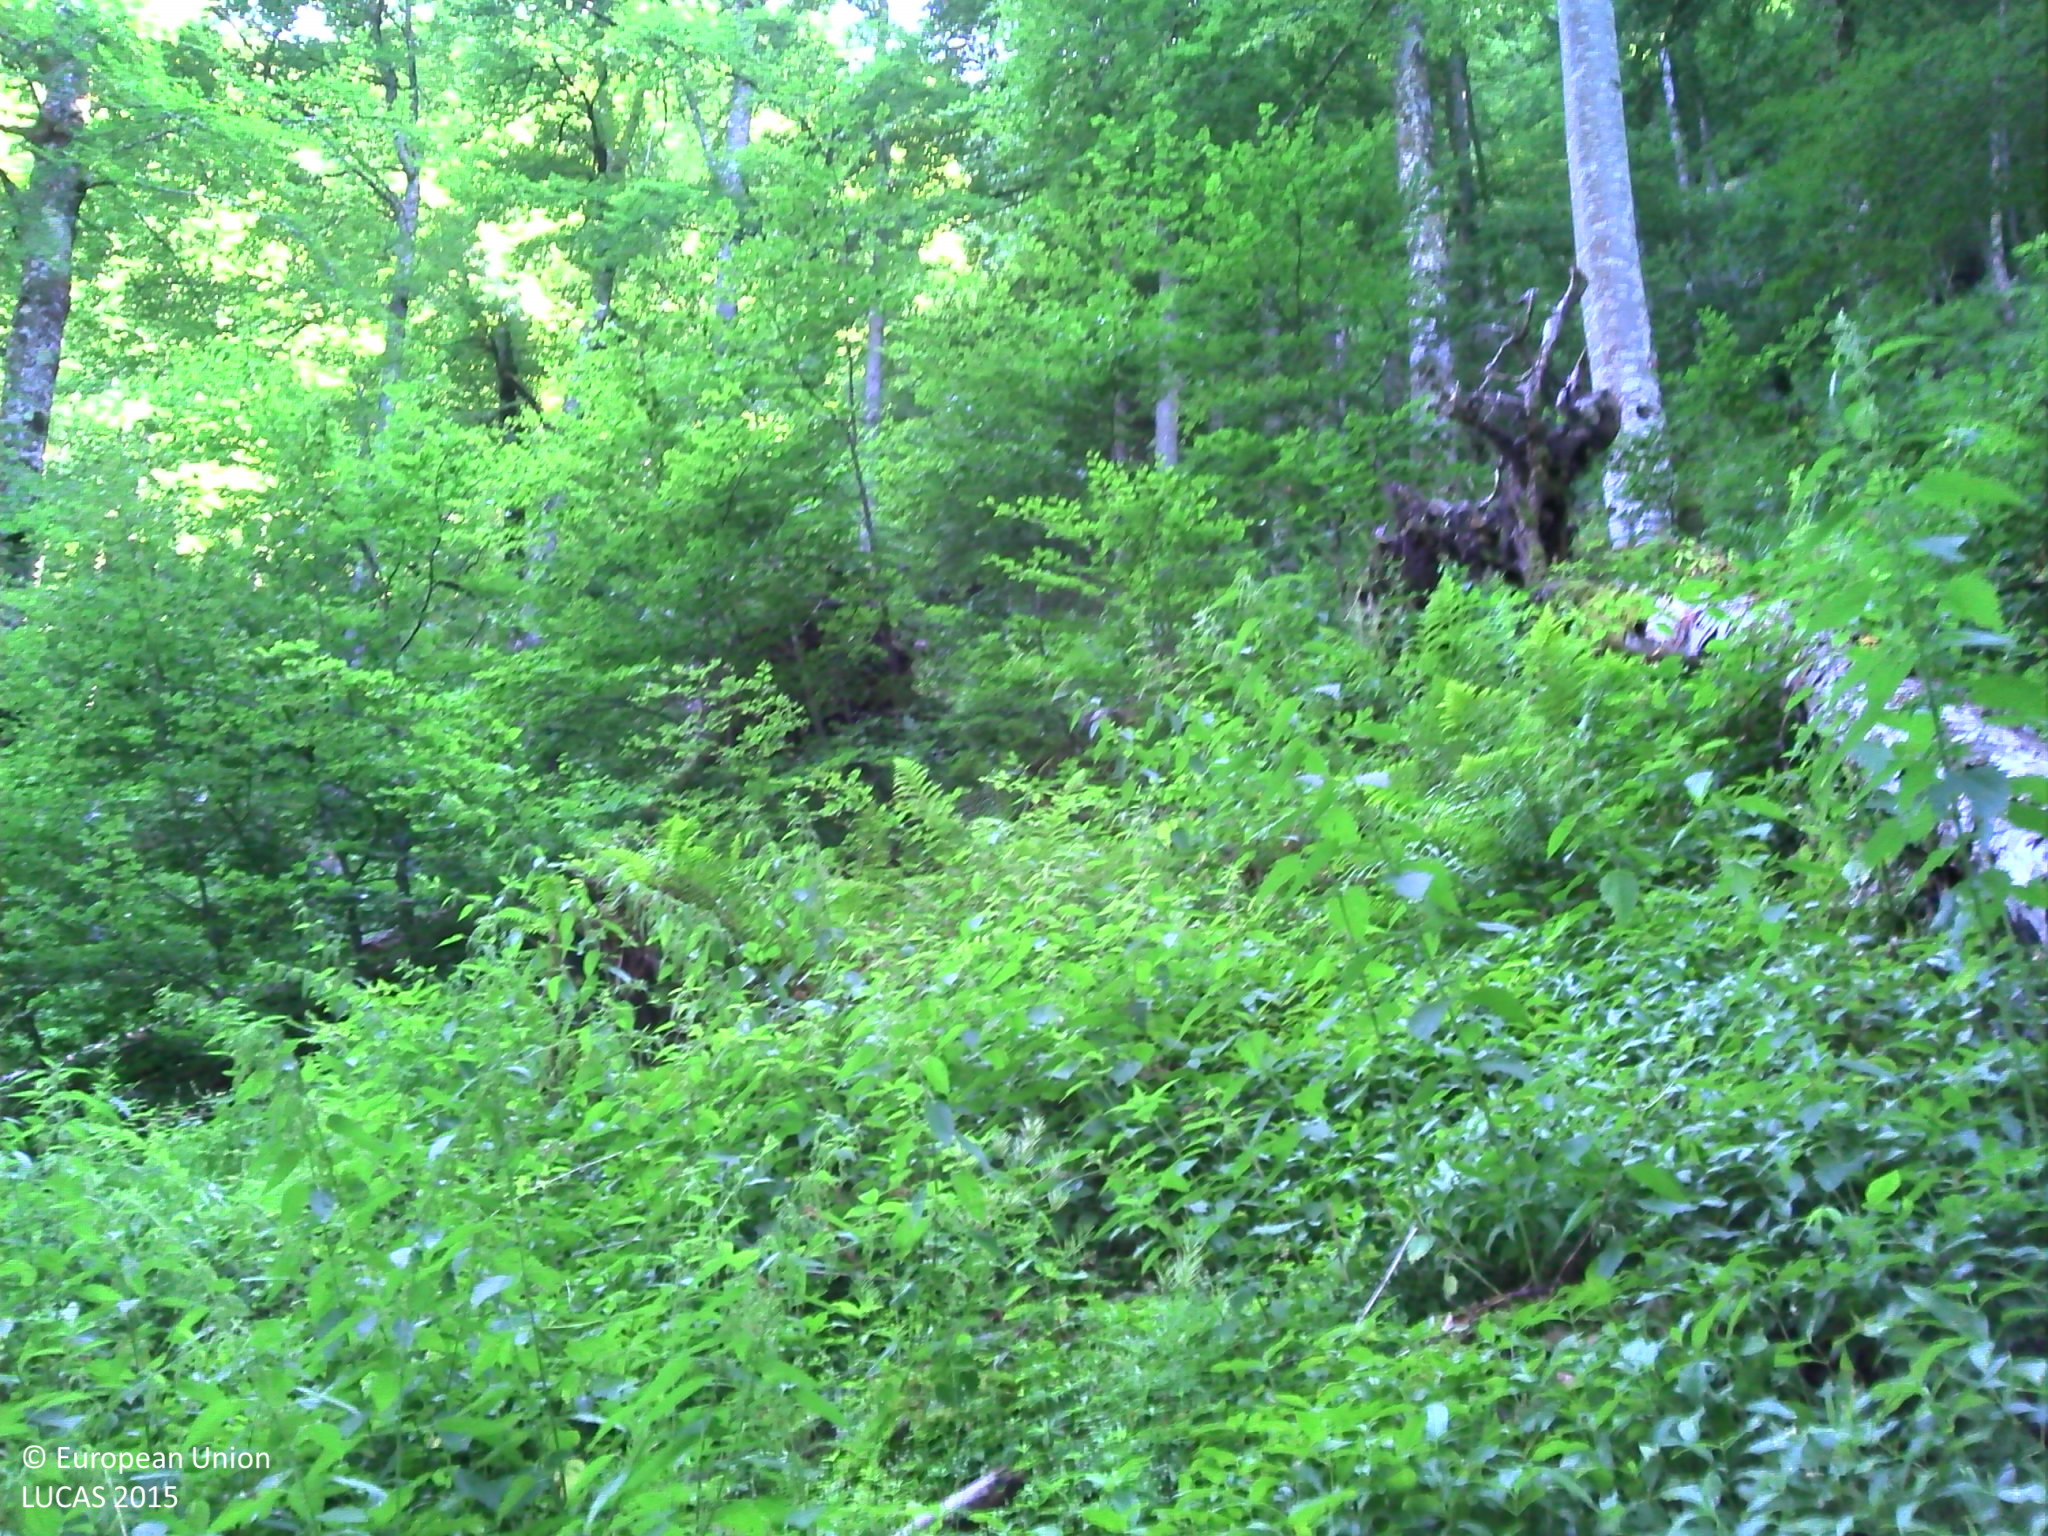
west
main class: Woodland
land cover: Broadleaved woodland
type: beech forest
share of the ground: > 75 %
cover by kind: broadleaved forest trees 50 %, herbaceous plants 50 %
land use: Forestry
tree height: > 5 m
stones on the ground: > 50 %
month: July
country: FR
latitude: 42.8592
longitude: 1.0832
